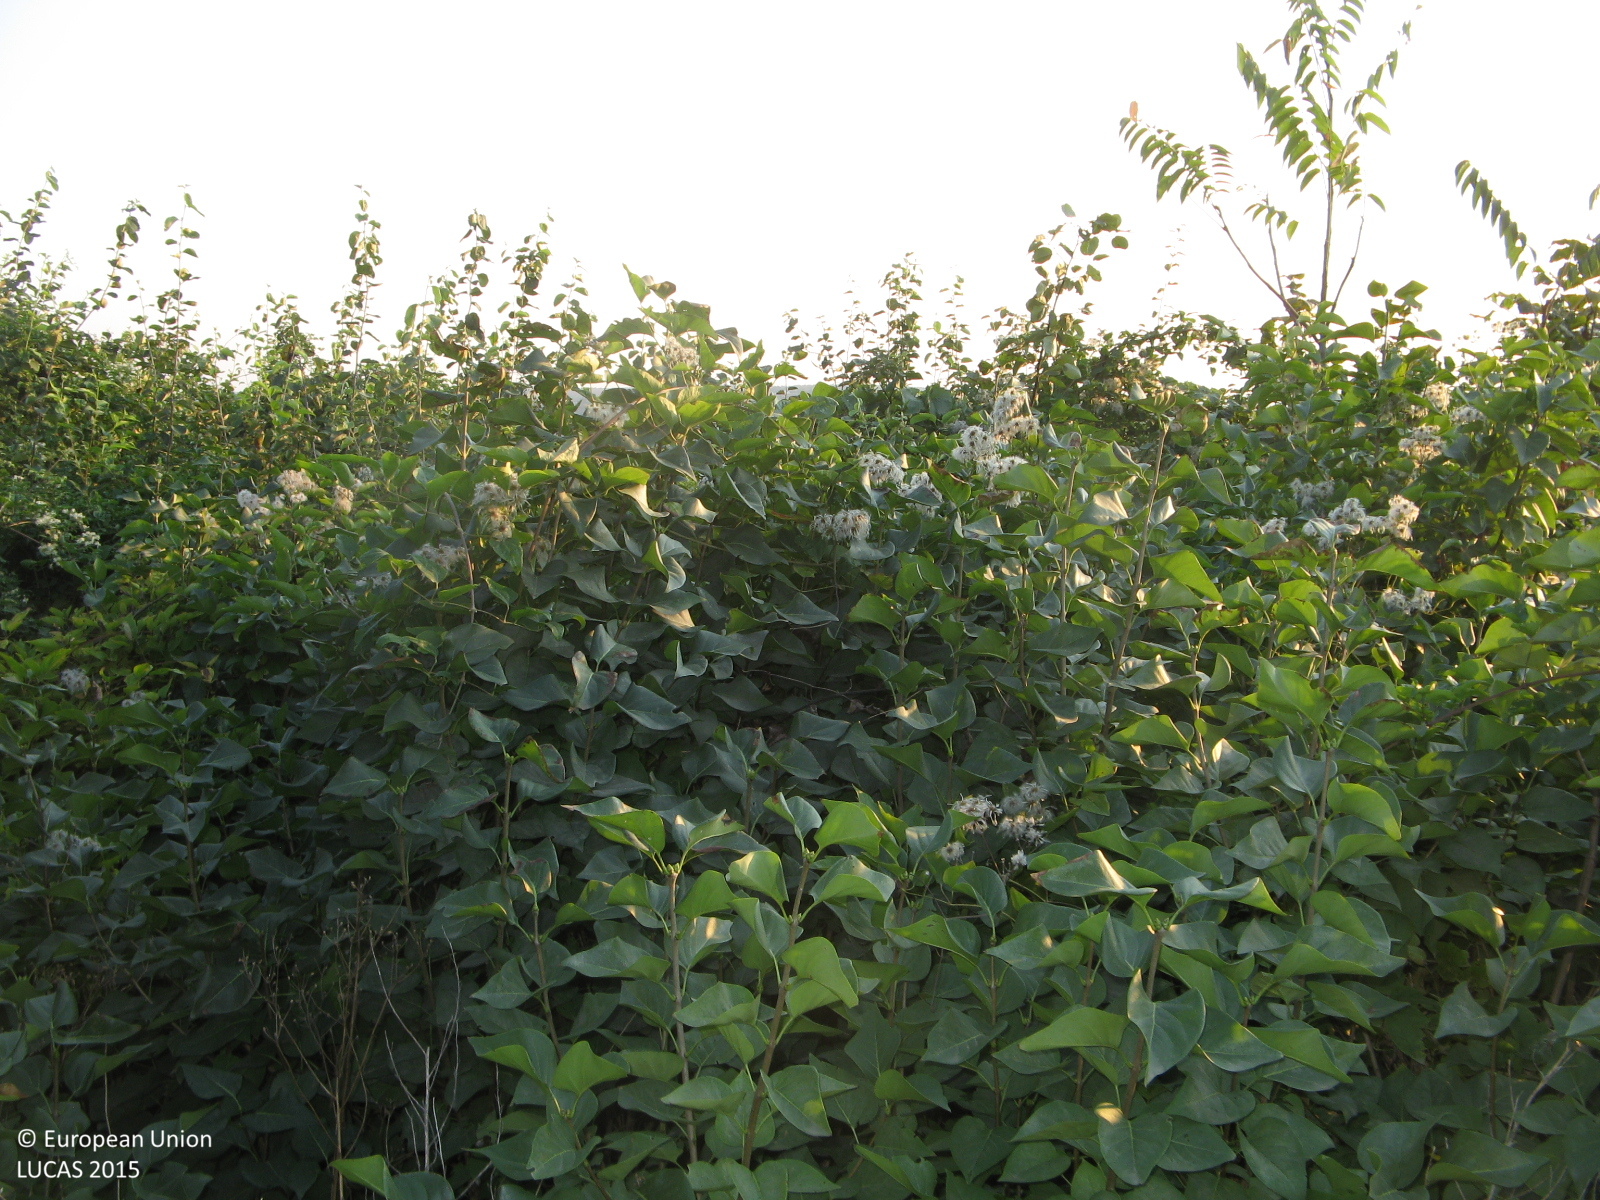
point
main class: Shrubland
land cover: Shrubland without tree cover
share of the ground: > 75 %
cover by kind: shrubs 90 %, herbaceous plants 10 %
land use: Abandoned areas
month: September
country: BG
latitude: 43.8235
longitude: 25.9485
